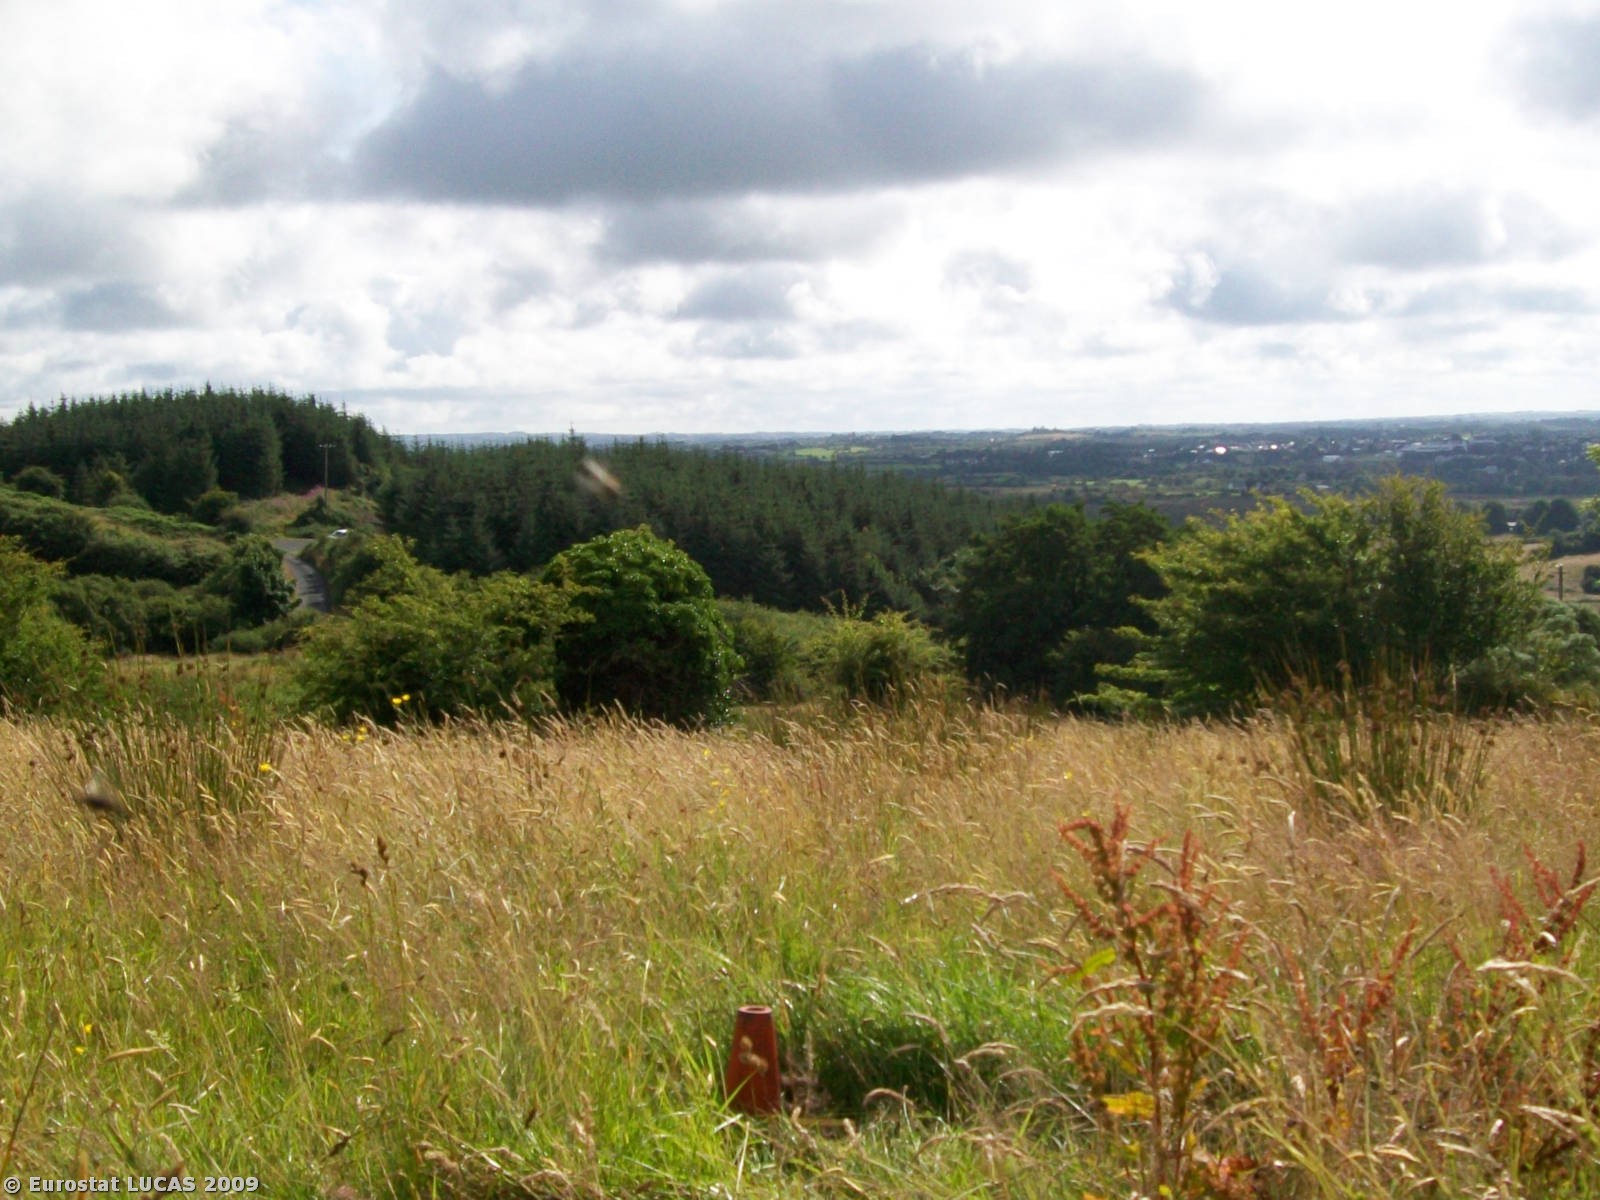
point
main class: Grassland
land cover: Grassland without tree/shrub cover
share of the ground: > 75 %
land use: Agriculture (excluding fallow land and kitchen gardens)
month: July
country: IE
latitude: 53.8498
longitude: -9.0477
